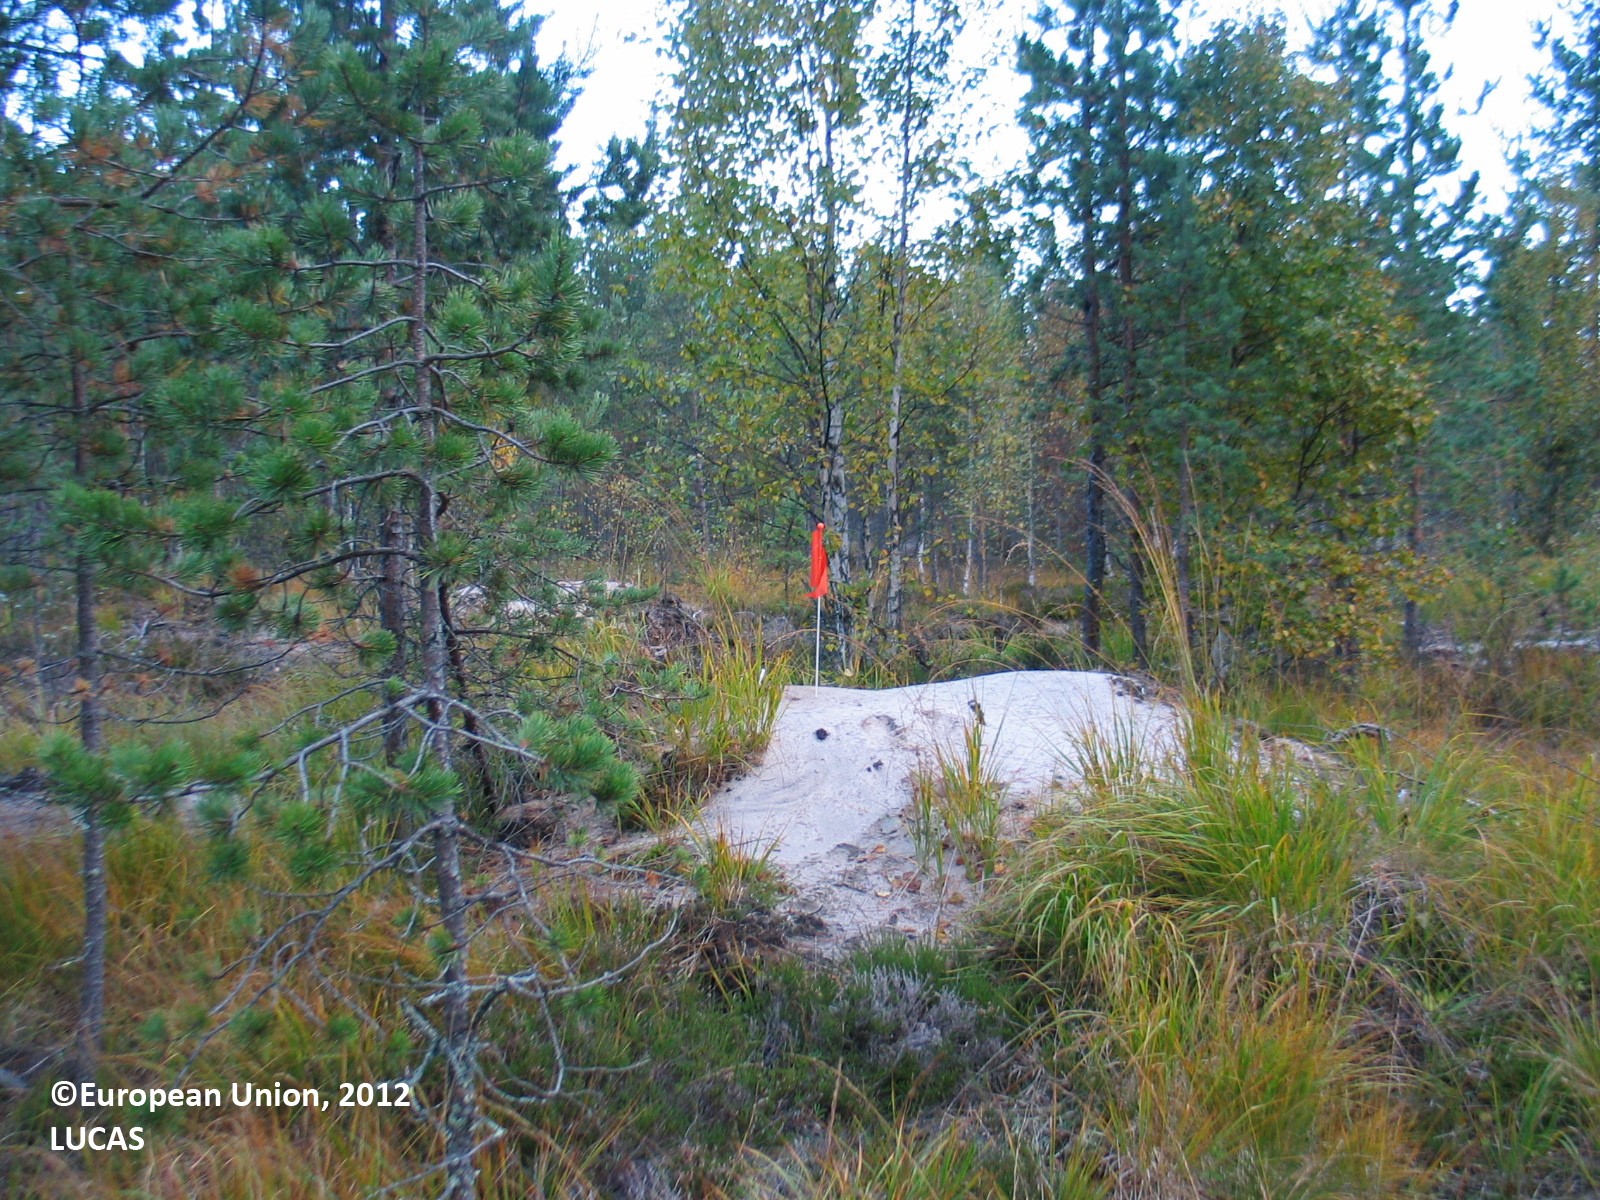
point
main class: Woodland
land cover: Pine dominated coniferous woodland
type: mire and swamp forests
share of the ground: 25 - 50 %
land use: Forestry
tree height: > 5 m
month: September
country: FI
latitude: 65.5402
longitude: 25.6425
